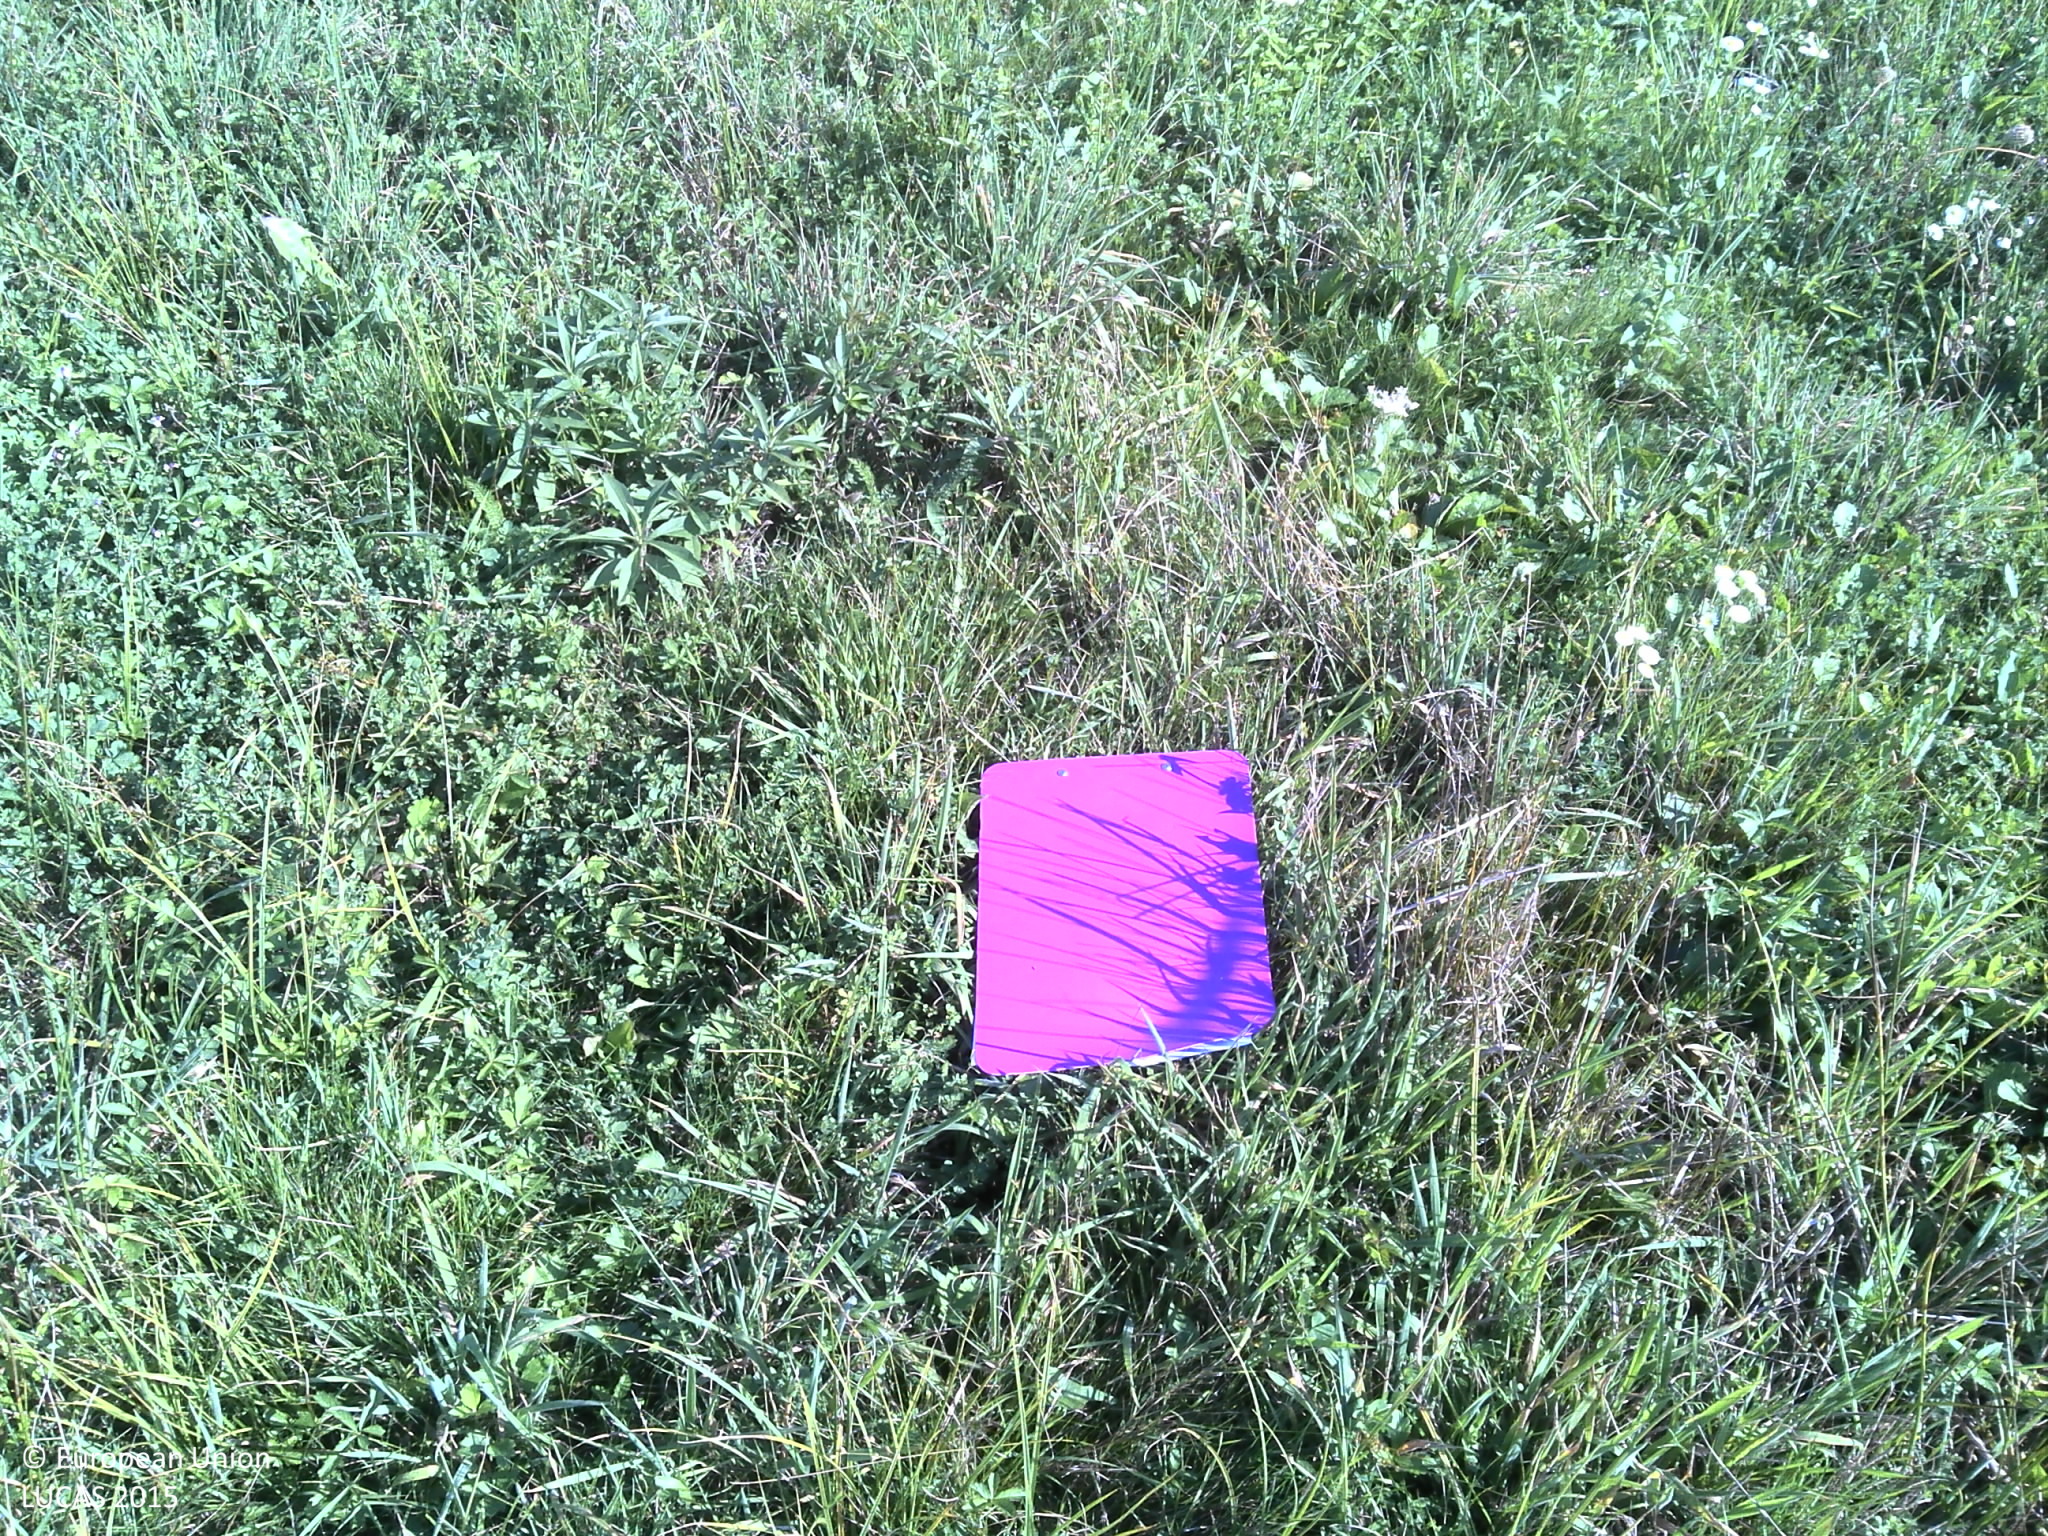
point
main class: Grassland
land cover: Grassland without tree/shrub cover
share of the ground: > 75 %
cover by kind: herbaceous plants 100 %
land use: Semi-natural and natural areas not in use
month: September
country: HR
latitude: 45.4816
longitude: 16.2535
